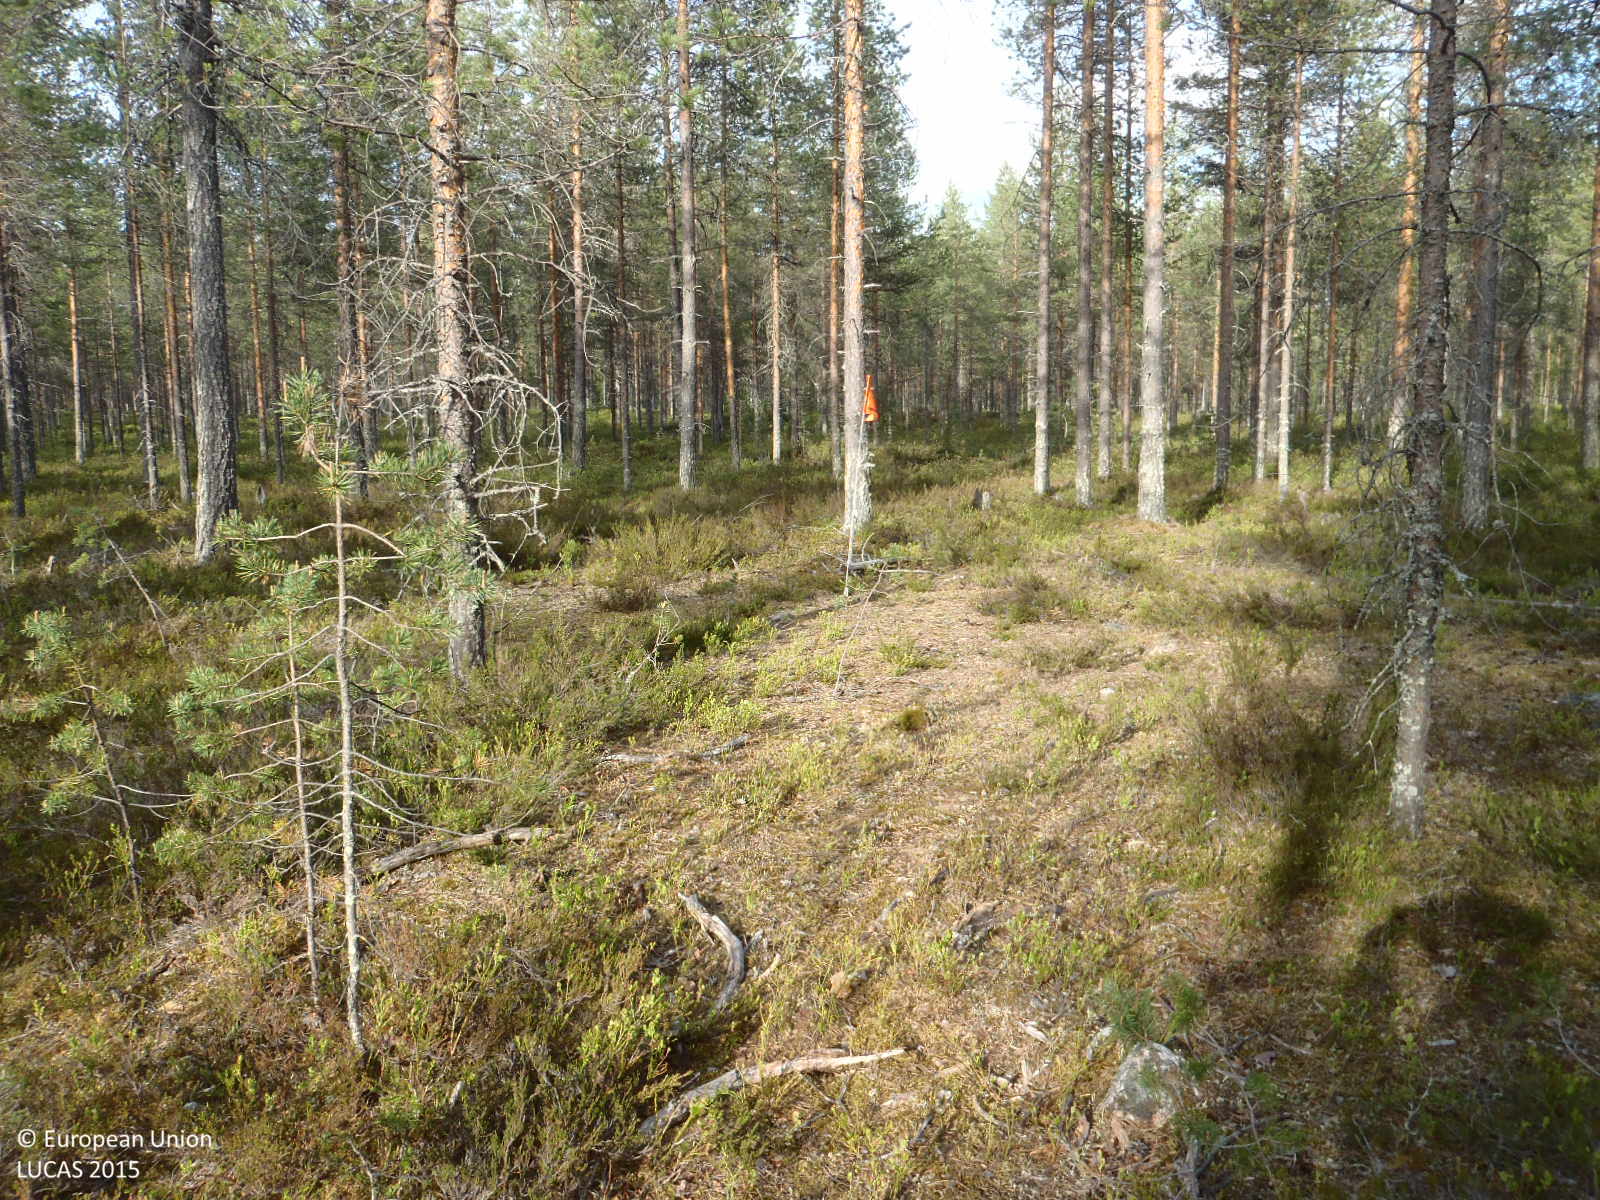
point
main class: Woodland
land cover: Pine dominated coniferous woodland
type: boreal forest
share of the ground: 50 - 75 %
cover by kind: coniferous forest trees 70 %, shrubs 25 %, lichens and mosses 5 %
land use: Forestry
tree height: > 5 m
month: June
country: FI
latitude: 65.2665
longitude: 26.8869
